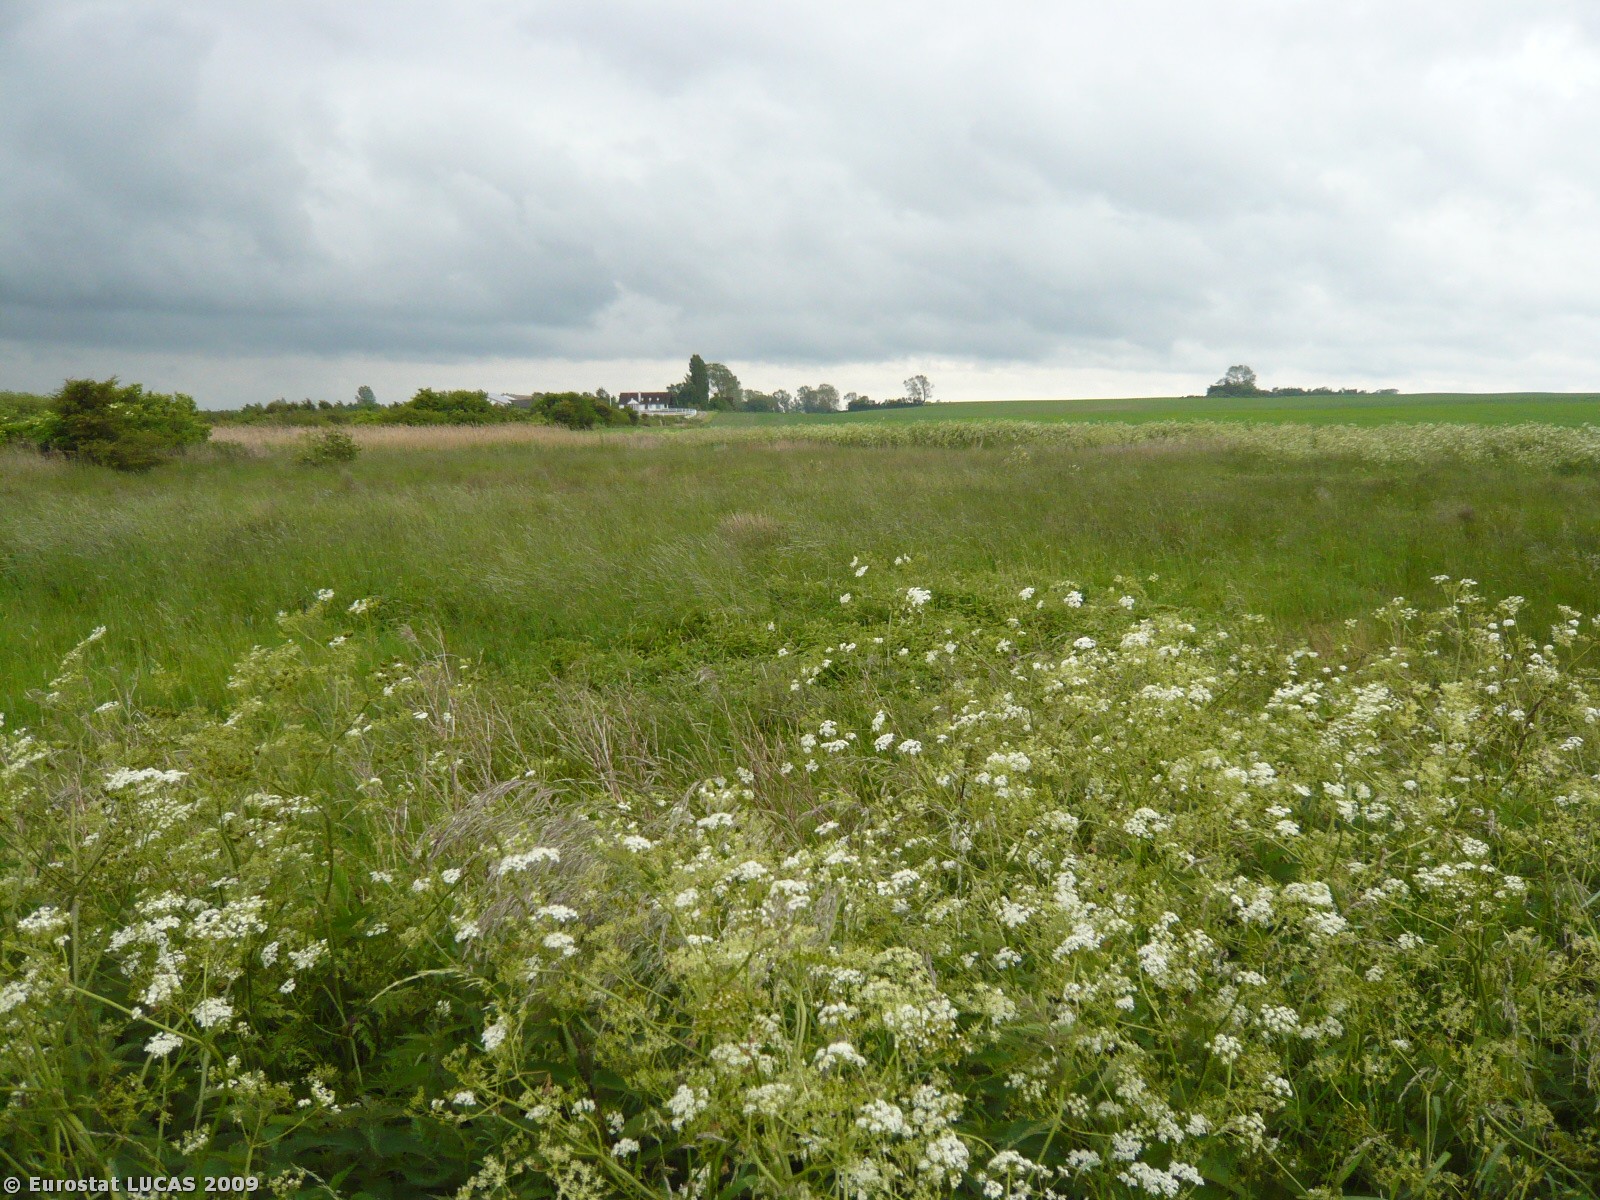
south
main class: Cropland
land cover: Barley
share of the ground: > 75 %
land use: Agriculture (excluding fallow land and kitchen gardens)
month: June
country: DK
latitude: 54.9149
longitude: 11.9175
